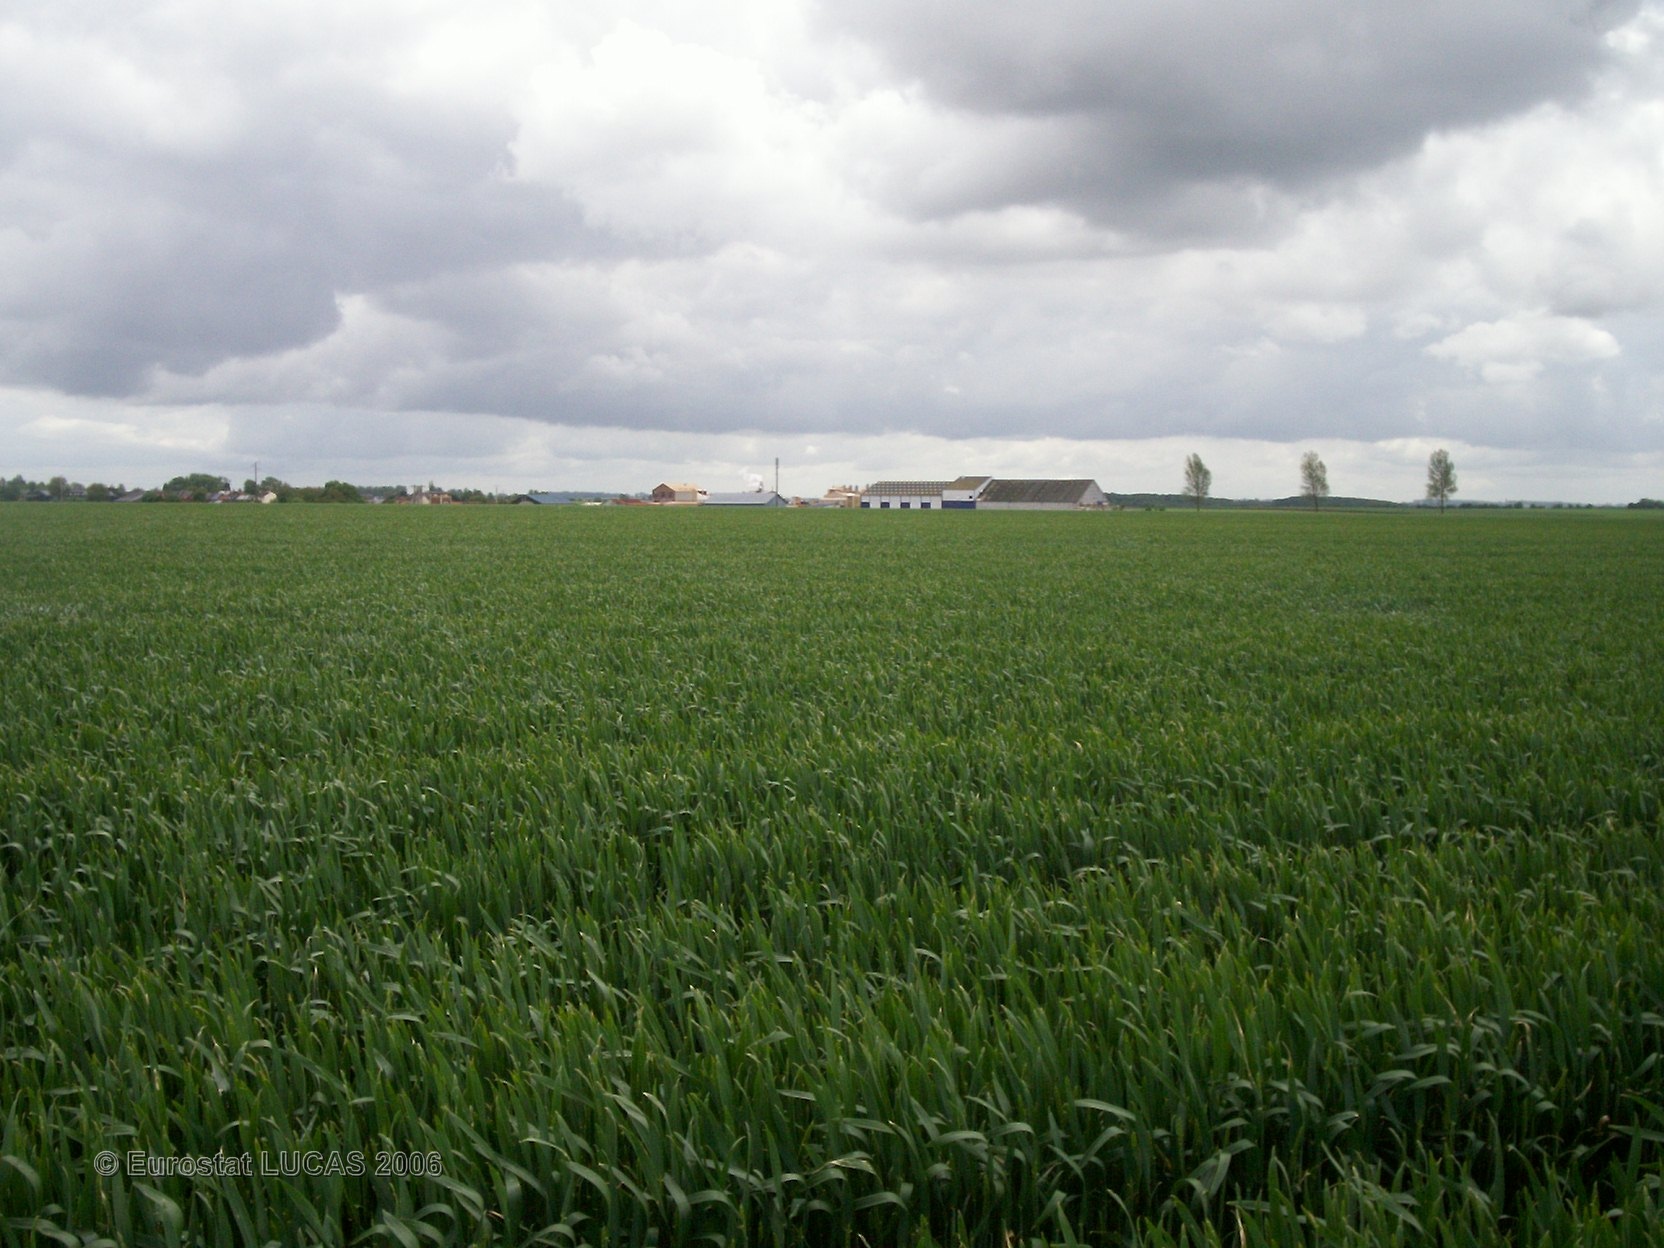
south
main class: Cropland
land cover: Common wheat
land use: Agriculture (excluding fallow land and kitchen gardens)
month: May
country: FR
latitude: 49.8571
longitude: 2.6581
